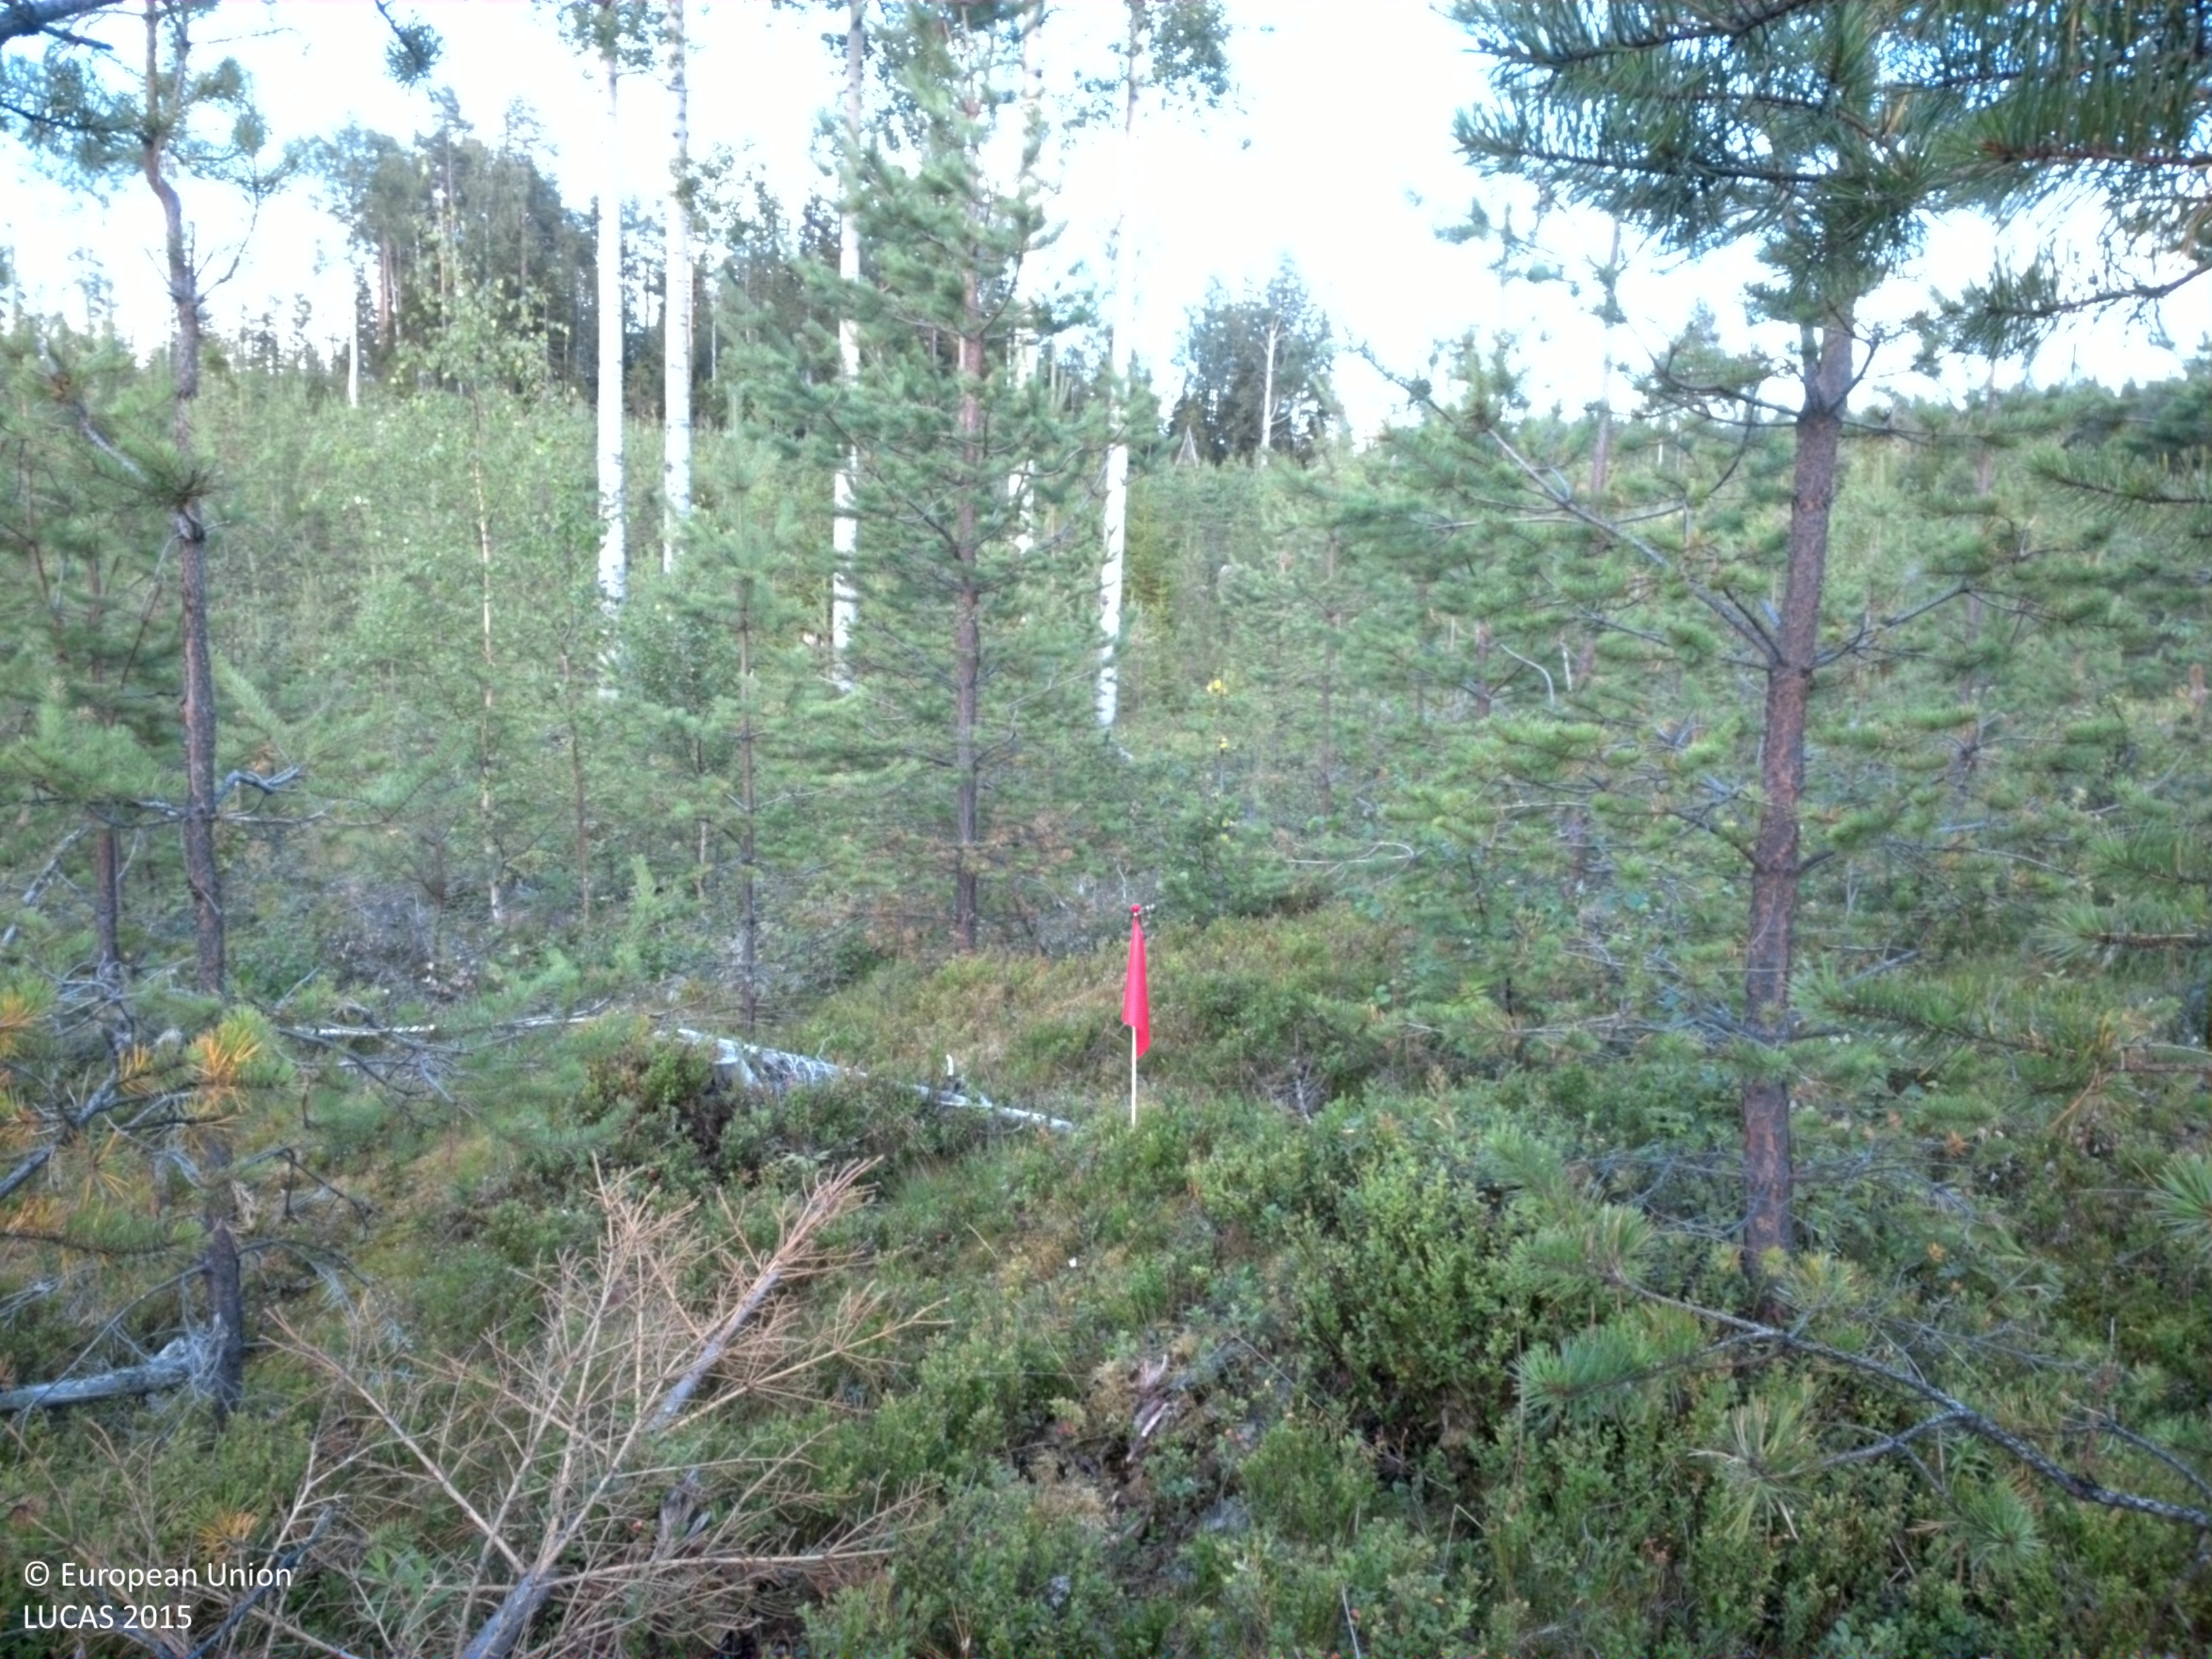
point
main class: Woodland
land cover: Pine dominated coniferous woodland
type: boreal forest
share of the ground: 25 - 50 %
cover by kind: coniferous forest trees 50 %, shrubs 40 %, lichens and mosses 10 %
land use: Forestry
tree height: < 5 m
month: August
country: SE
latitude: 64.3888
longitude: 18.8236
